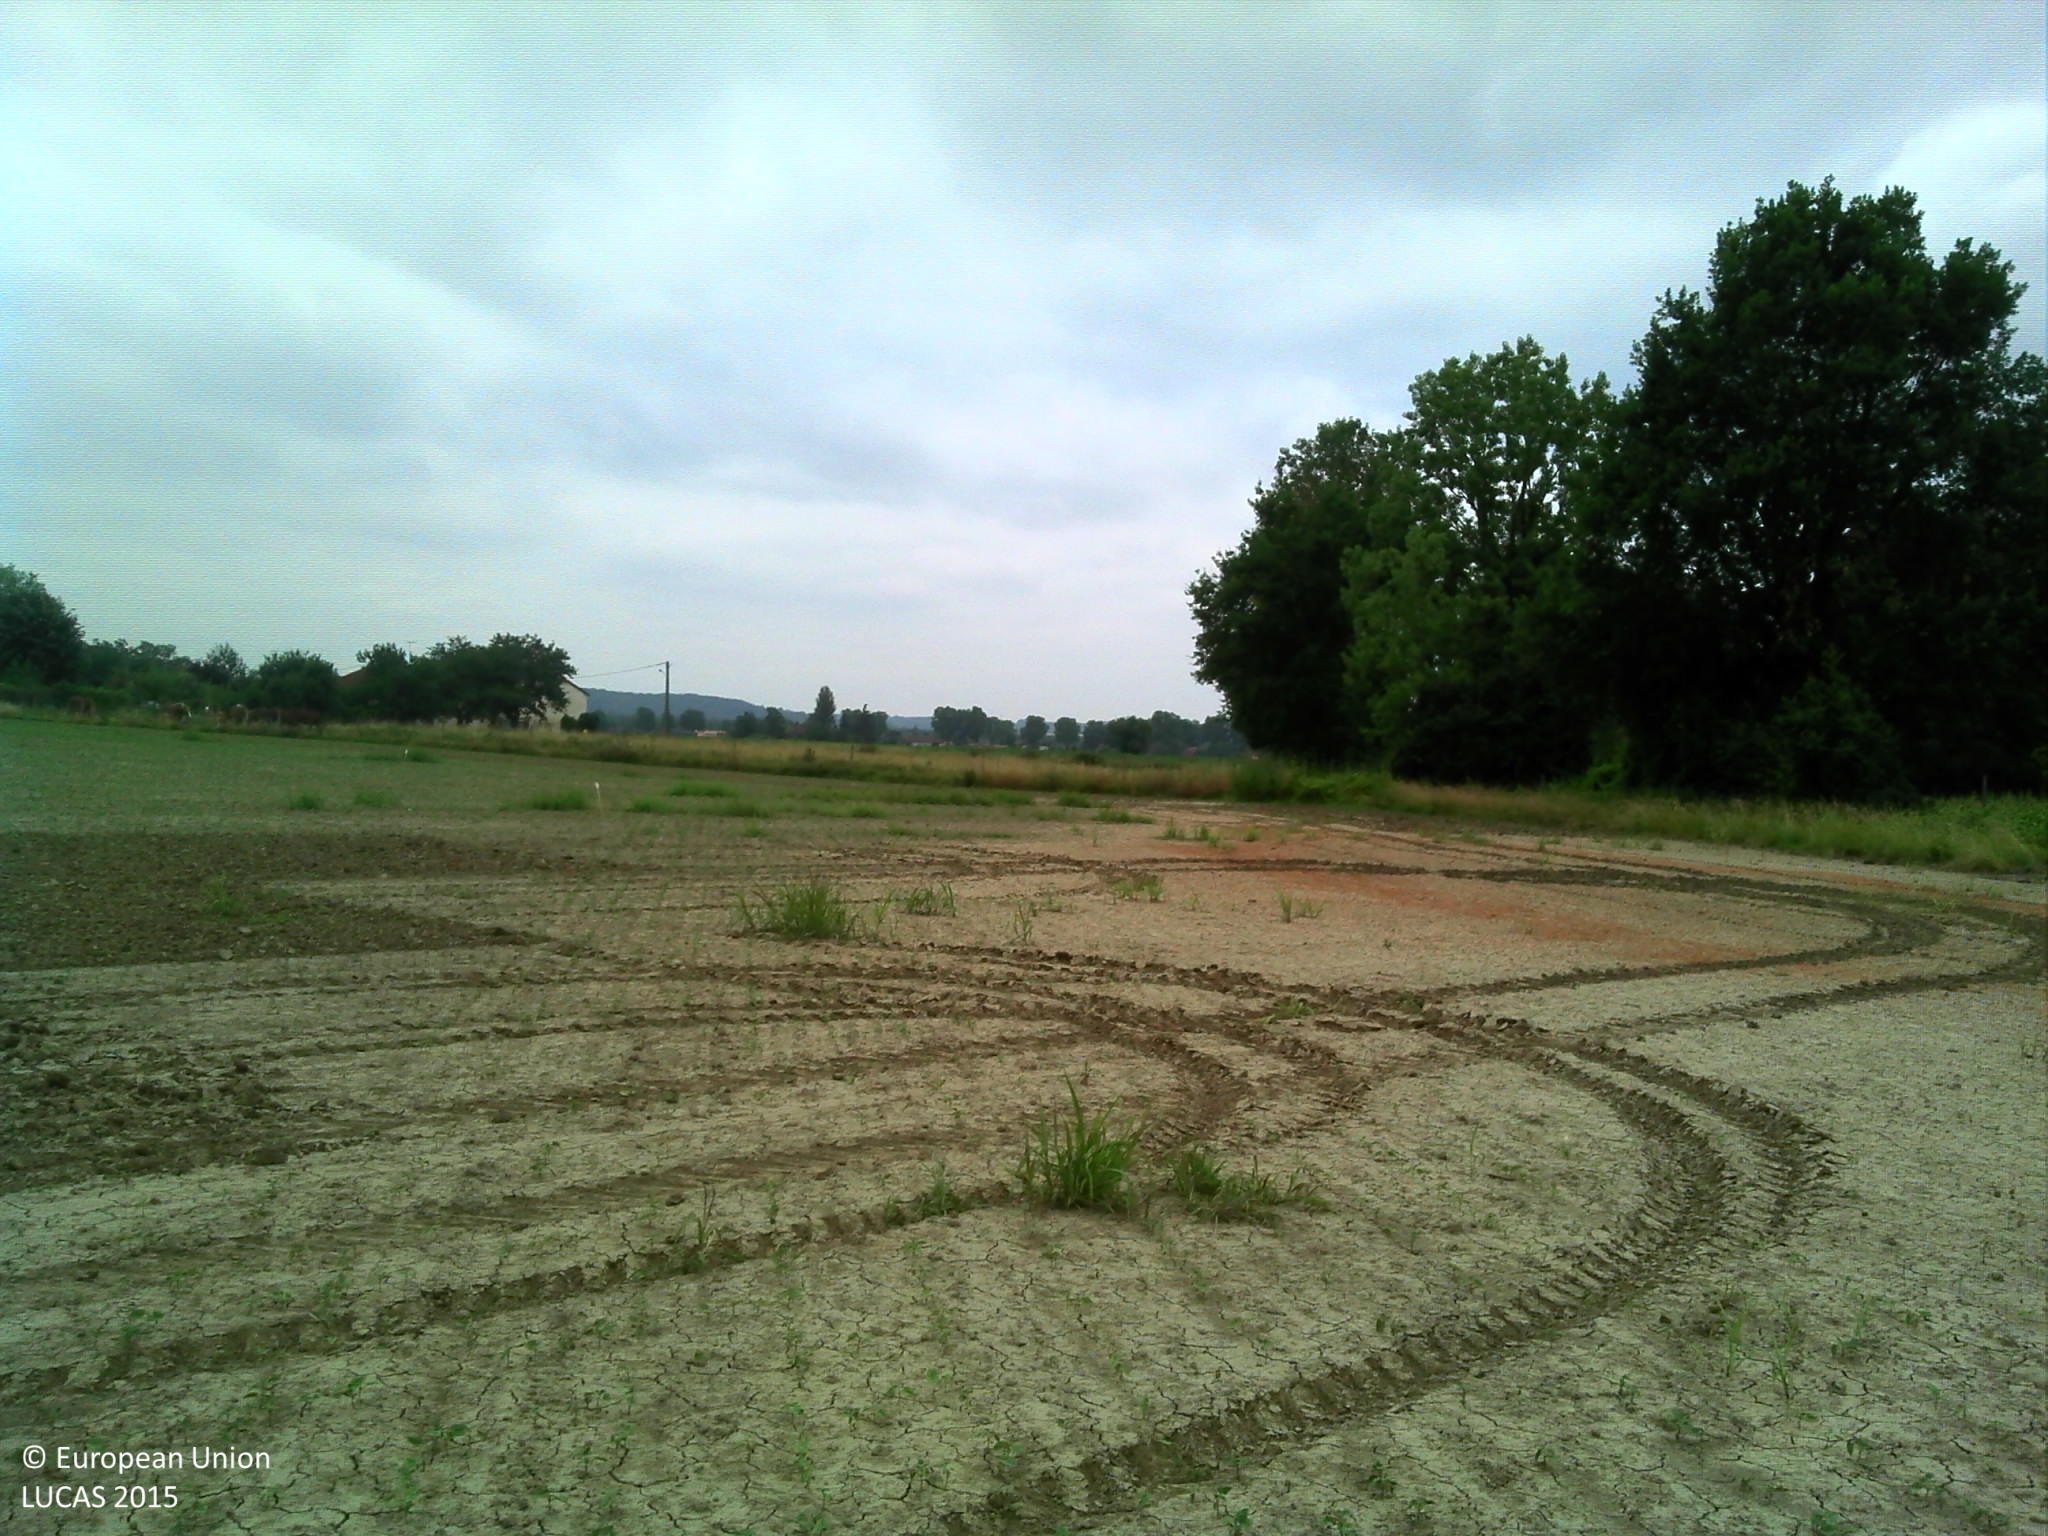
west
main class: Cropland
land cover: Other fresh vegetables
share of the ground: < 10 %
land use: Agriculture (excluding fallow land and kitchen gardens)
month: June
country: FR
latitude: 44.0966
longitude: 0.9160
